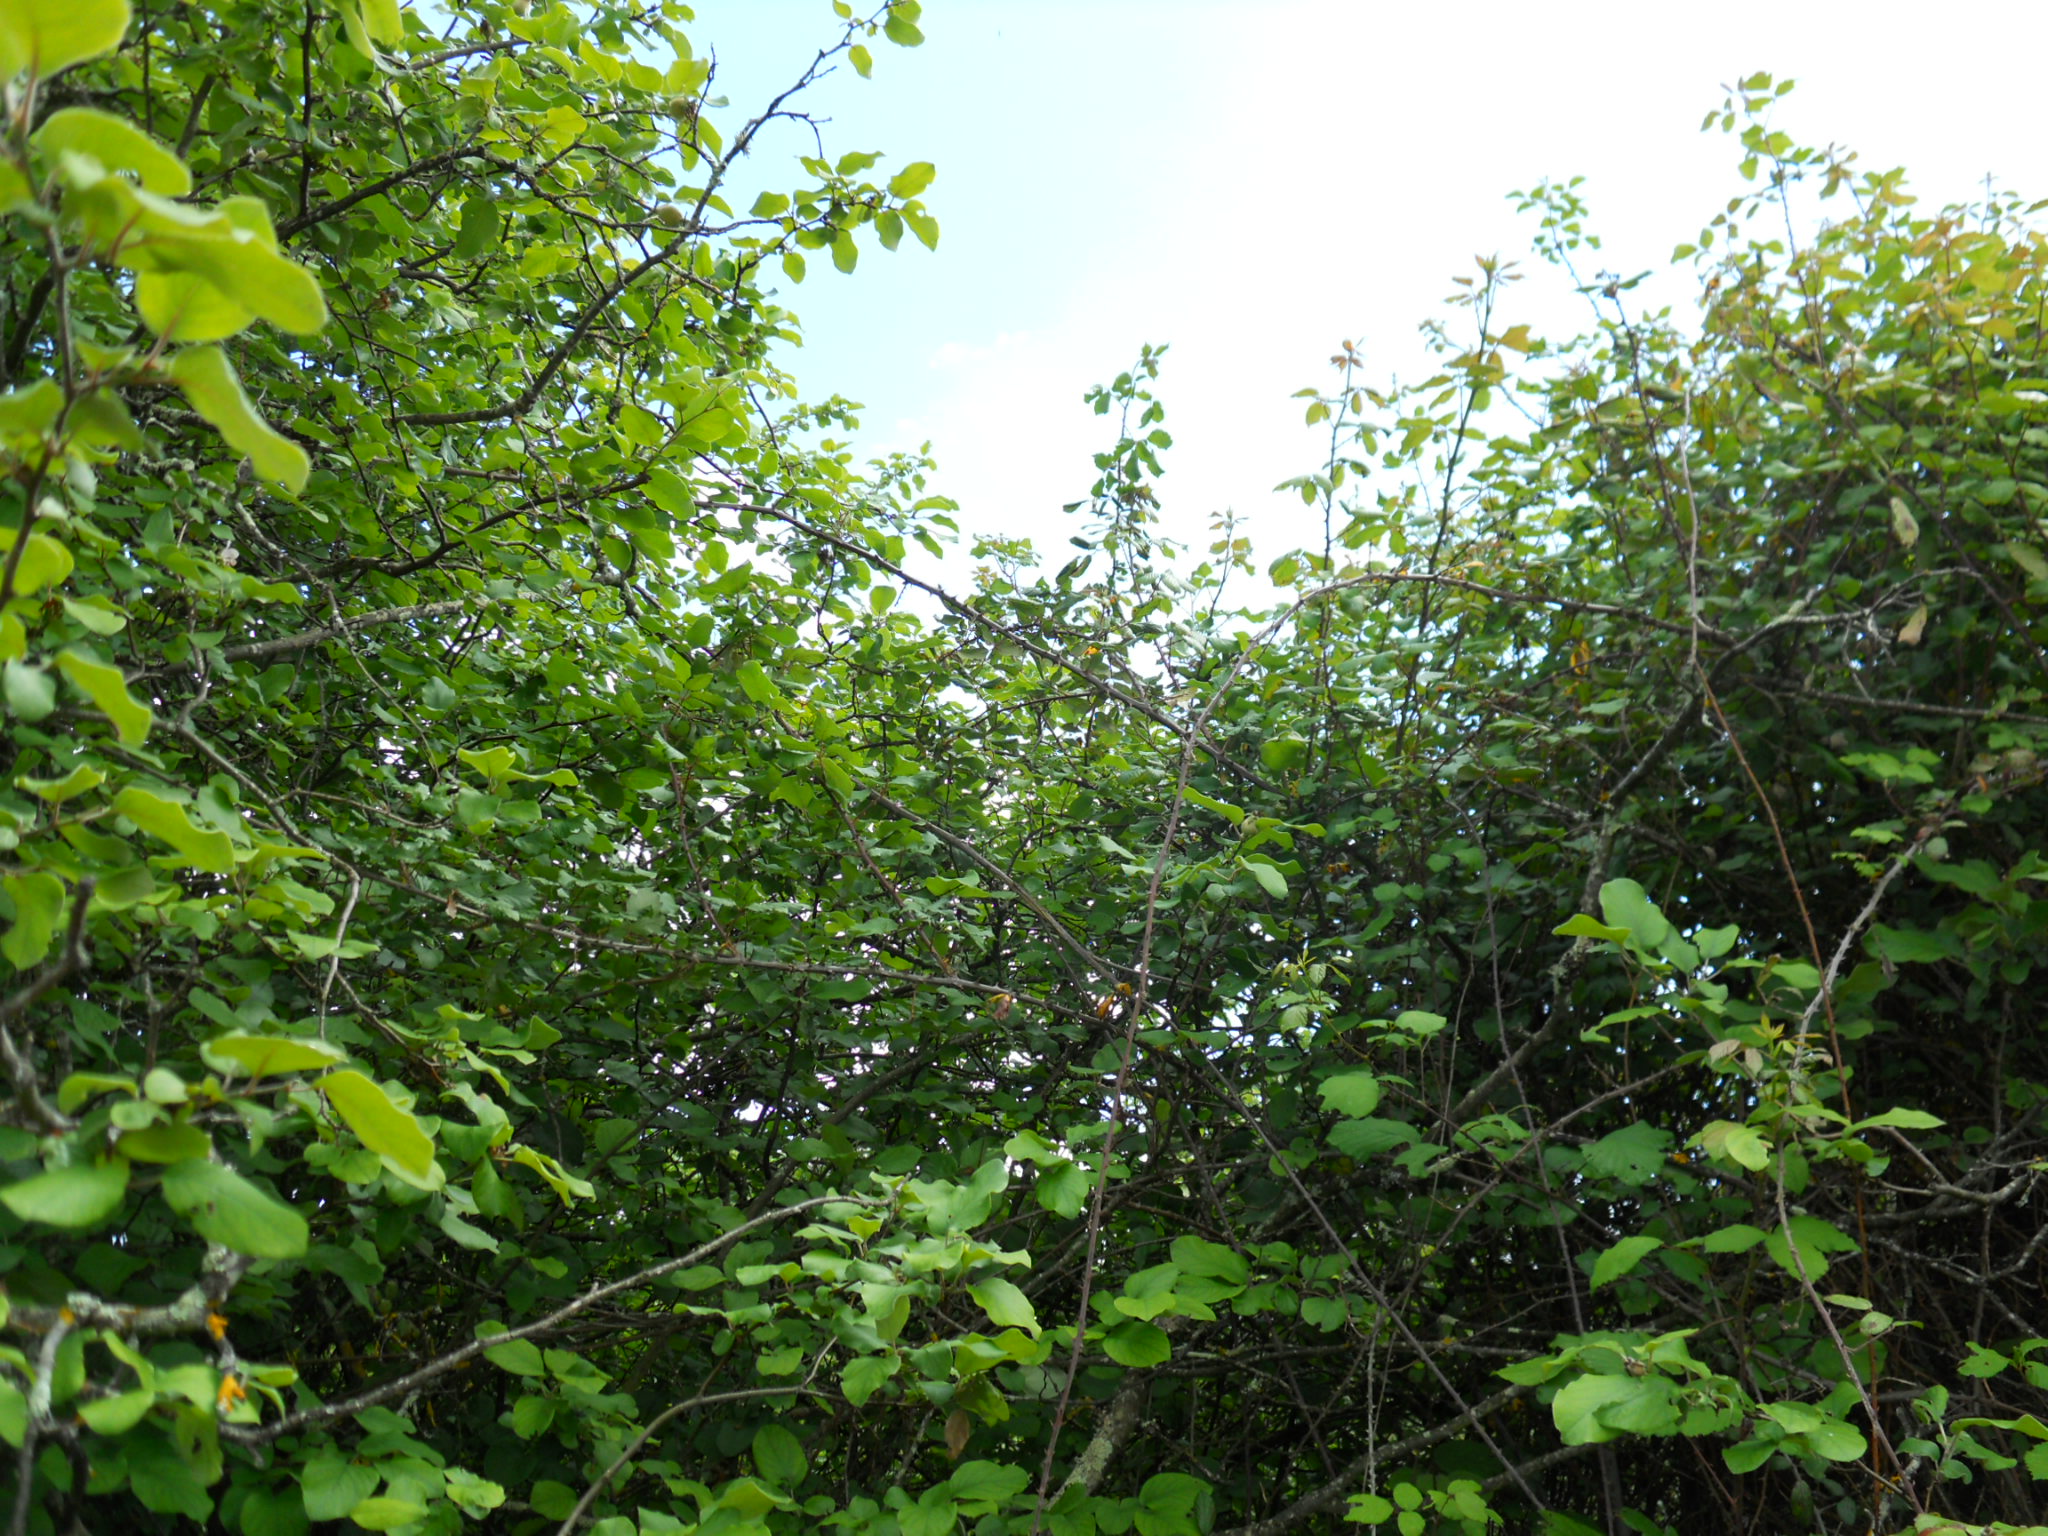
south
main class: Shrubland
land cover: Shrubland with sparse tree cover
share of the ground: > 75 %
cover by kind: shrubs 80 %, herbaceous plants 15 %, broadleaved forest trees 5 %
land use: Agriculture (excluding fallow land and kitchen gardens)
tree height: > 5 m
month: May
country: ES
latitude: 39.1616
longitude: -6.9835
